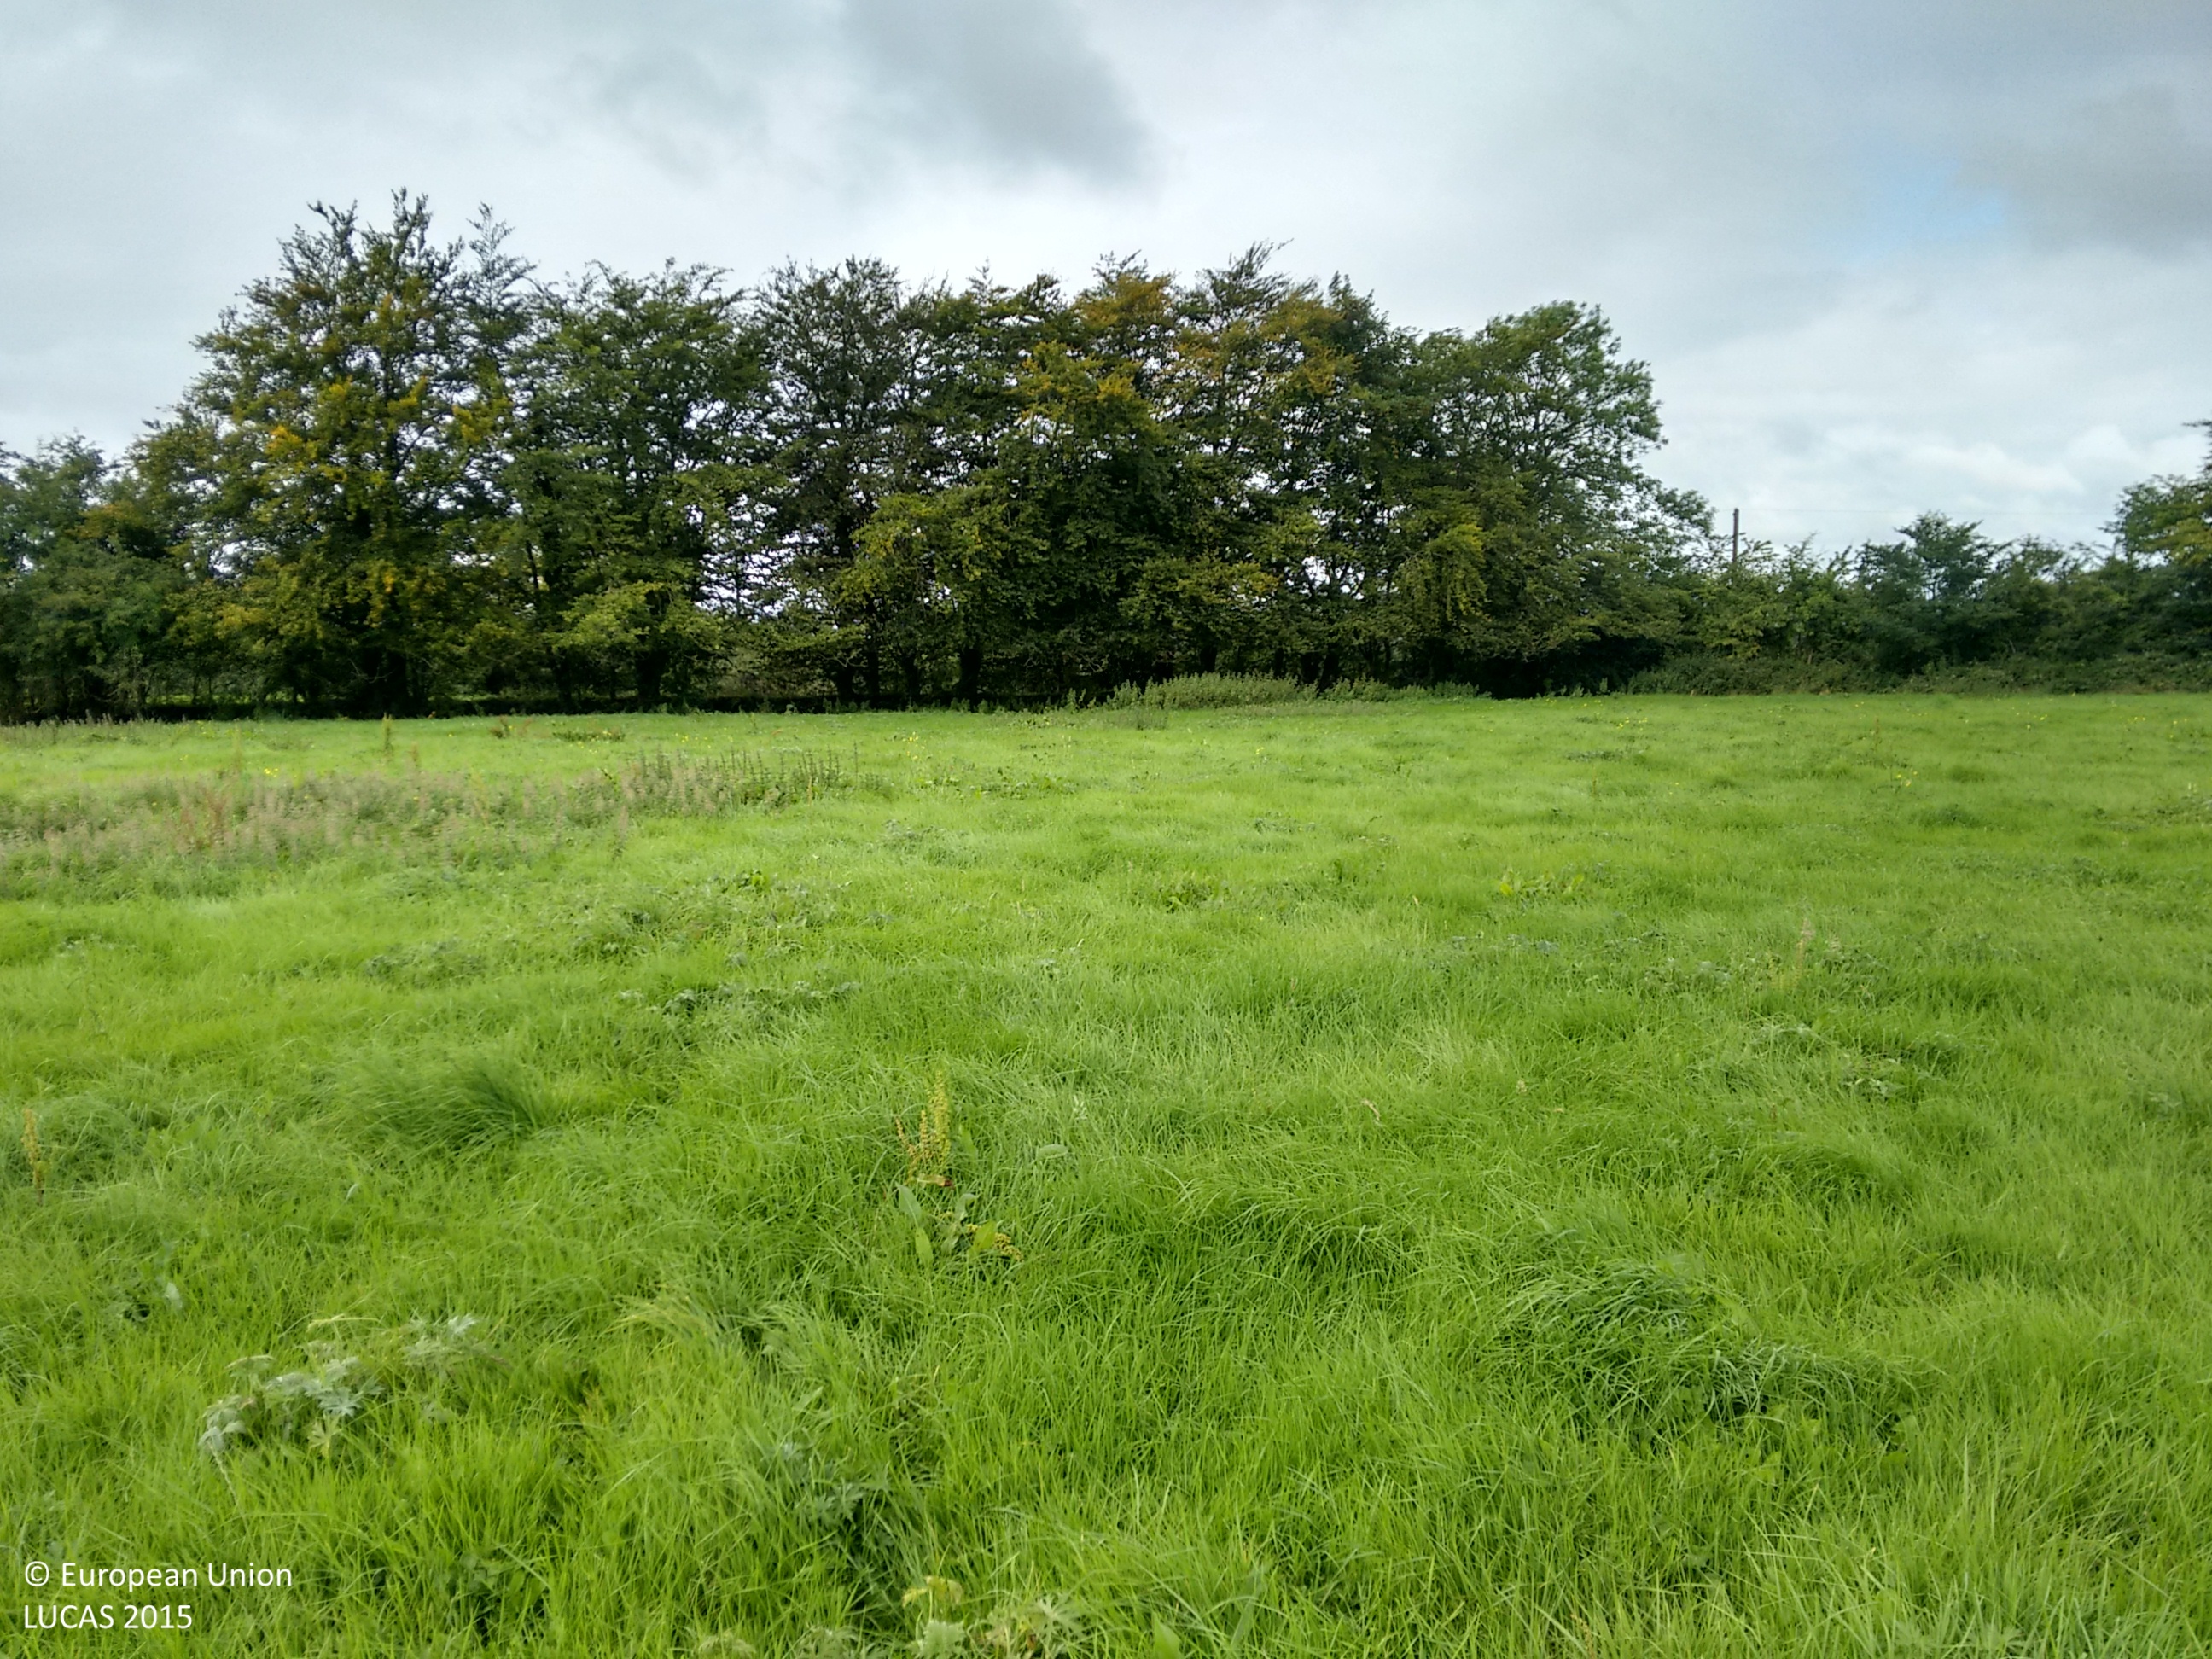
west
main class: Grassland
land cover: Grassland without tree/shrub cover
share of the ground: > 75 %
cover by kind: herbaceous plants 100 %
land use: Agriculture (excluding fallow land and kitchen gardens)
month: September
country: IE
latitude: 52.3847
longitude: -8.4854
